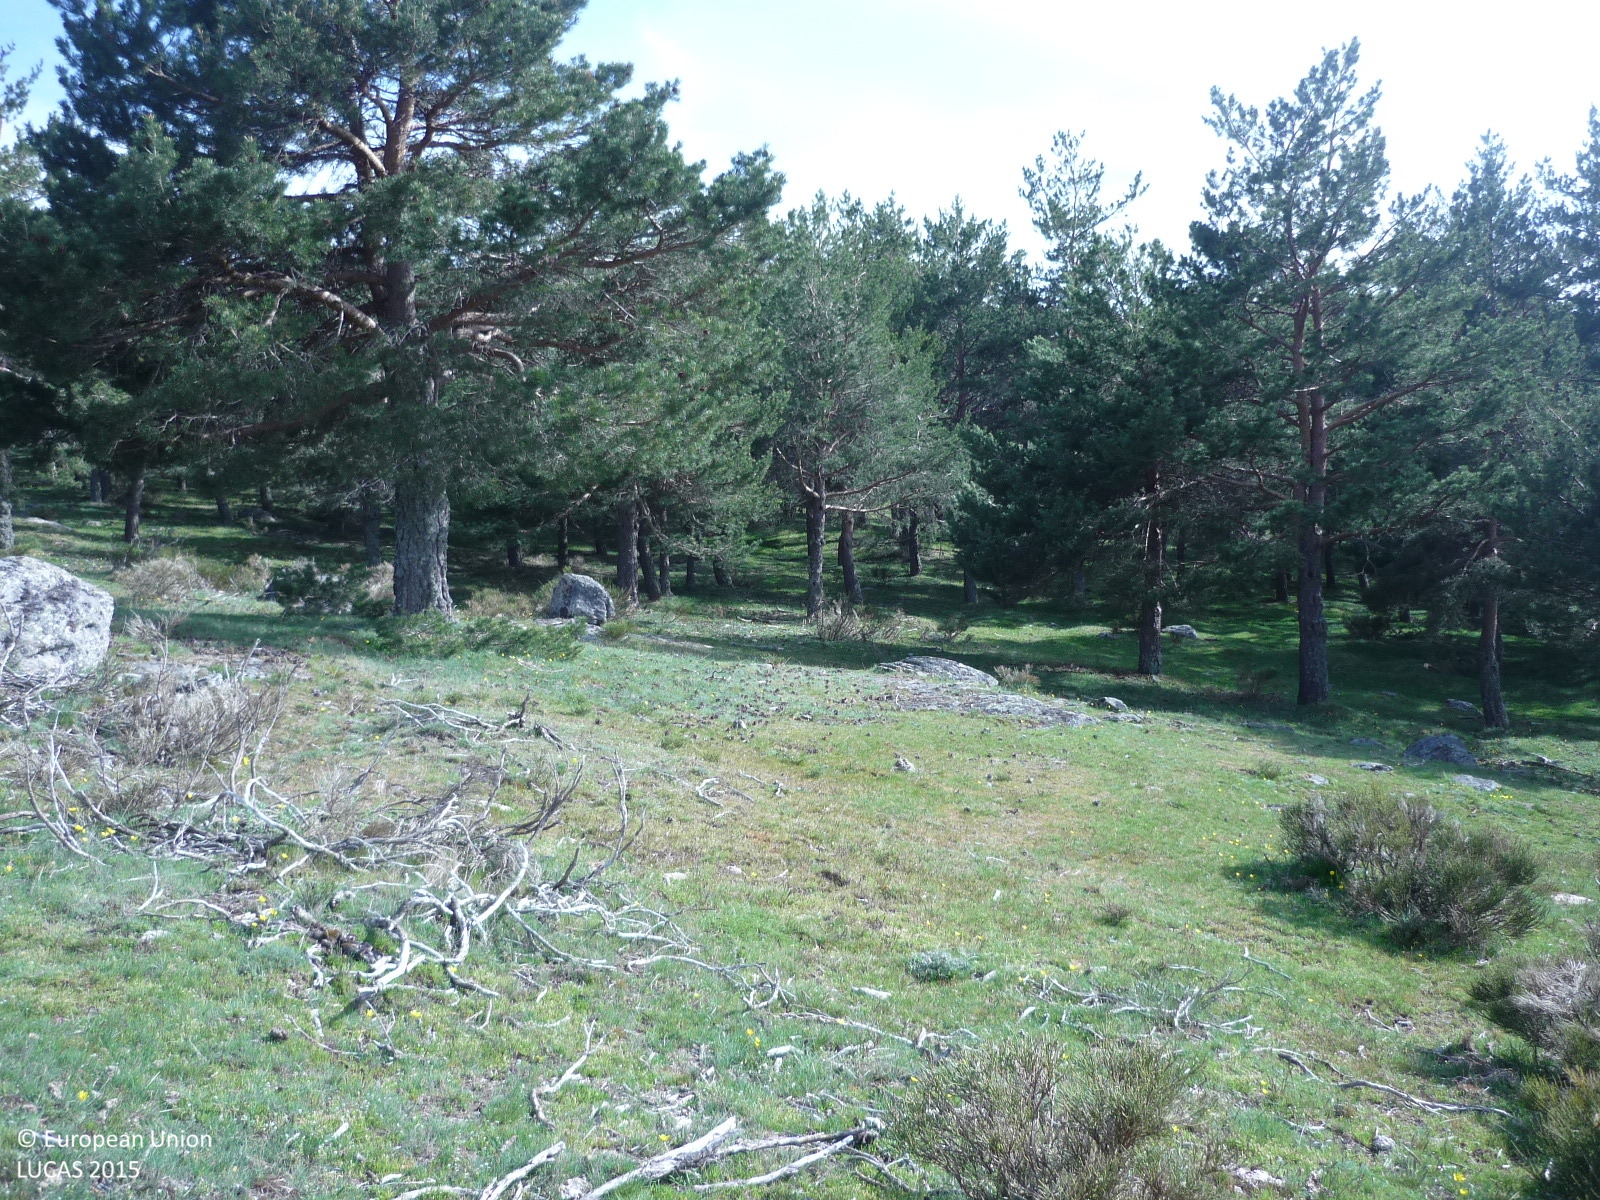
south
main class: Grassland
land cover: Grassland with sparse tree/shrub cover
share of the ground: > 75 %
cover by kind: herbaceous plants 85 %, shrubs 10 %, coniferous forest trees 5 %
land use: Agriculture (excluding fallow land and kitchen gardens)
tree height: < 5 m
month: May
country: ES
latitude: 40.8388
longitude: -3.8375
